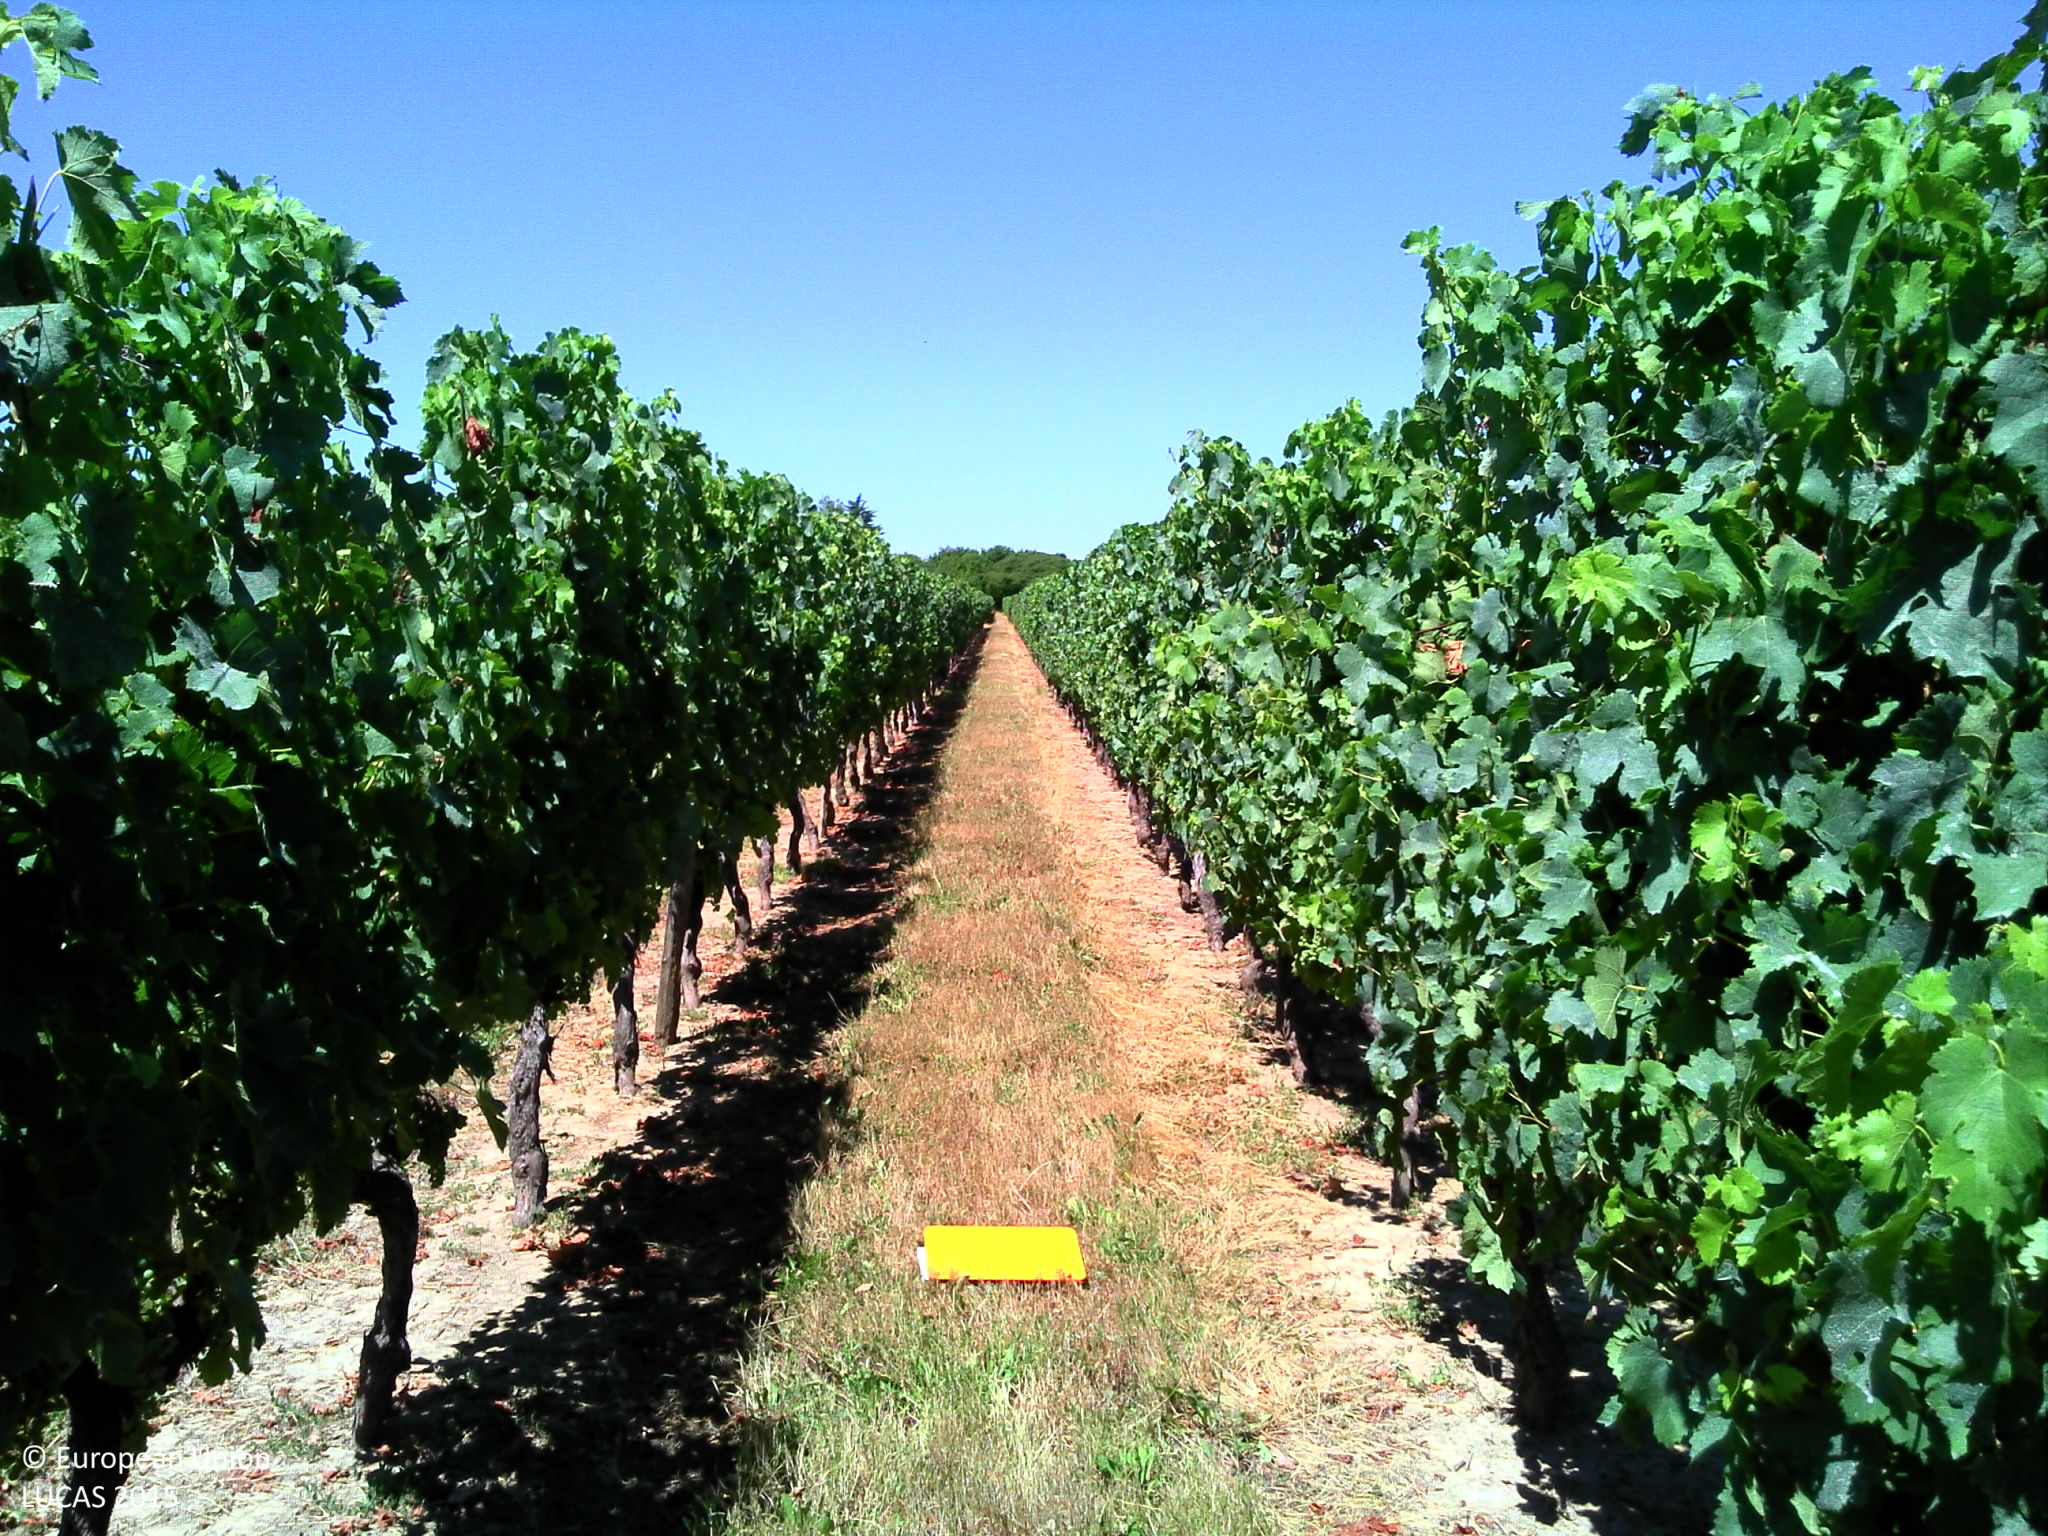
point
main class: Cropland
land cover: Vineyards
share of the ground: 25 - 50 %
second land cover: Grassland without tree/shrub cover
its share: > 75 %
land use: Agriculture (excluding fallow land and kitchen gardens)
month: July
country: FR
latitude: 44.8205
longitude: 0.4929
